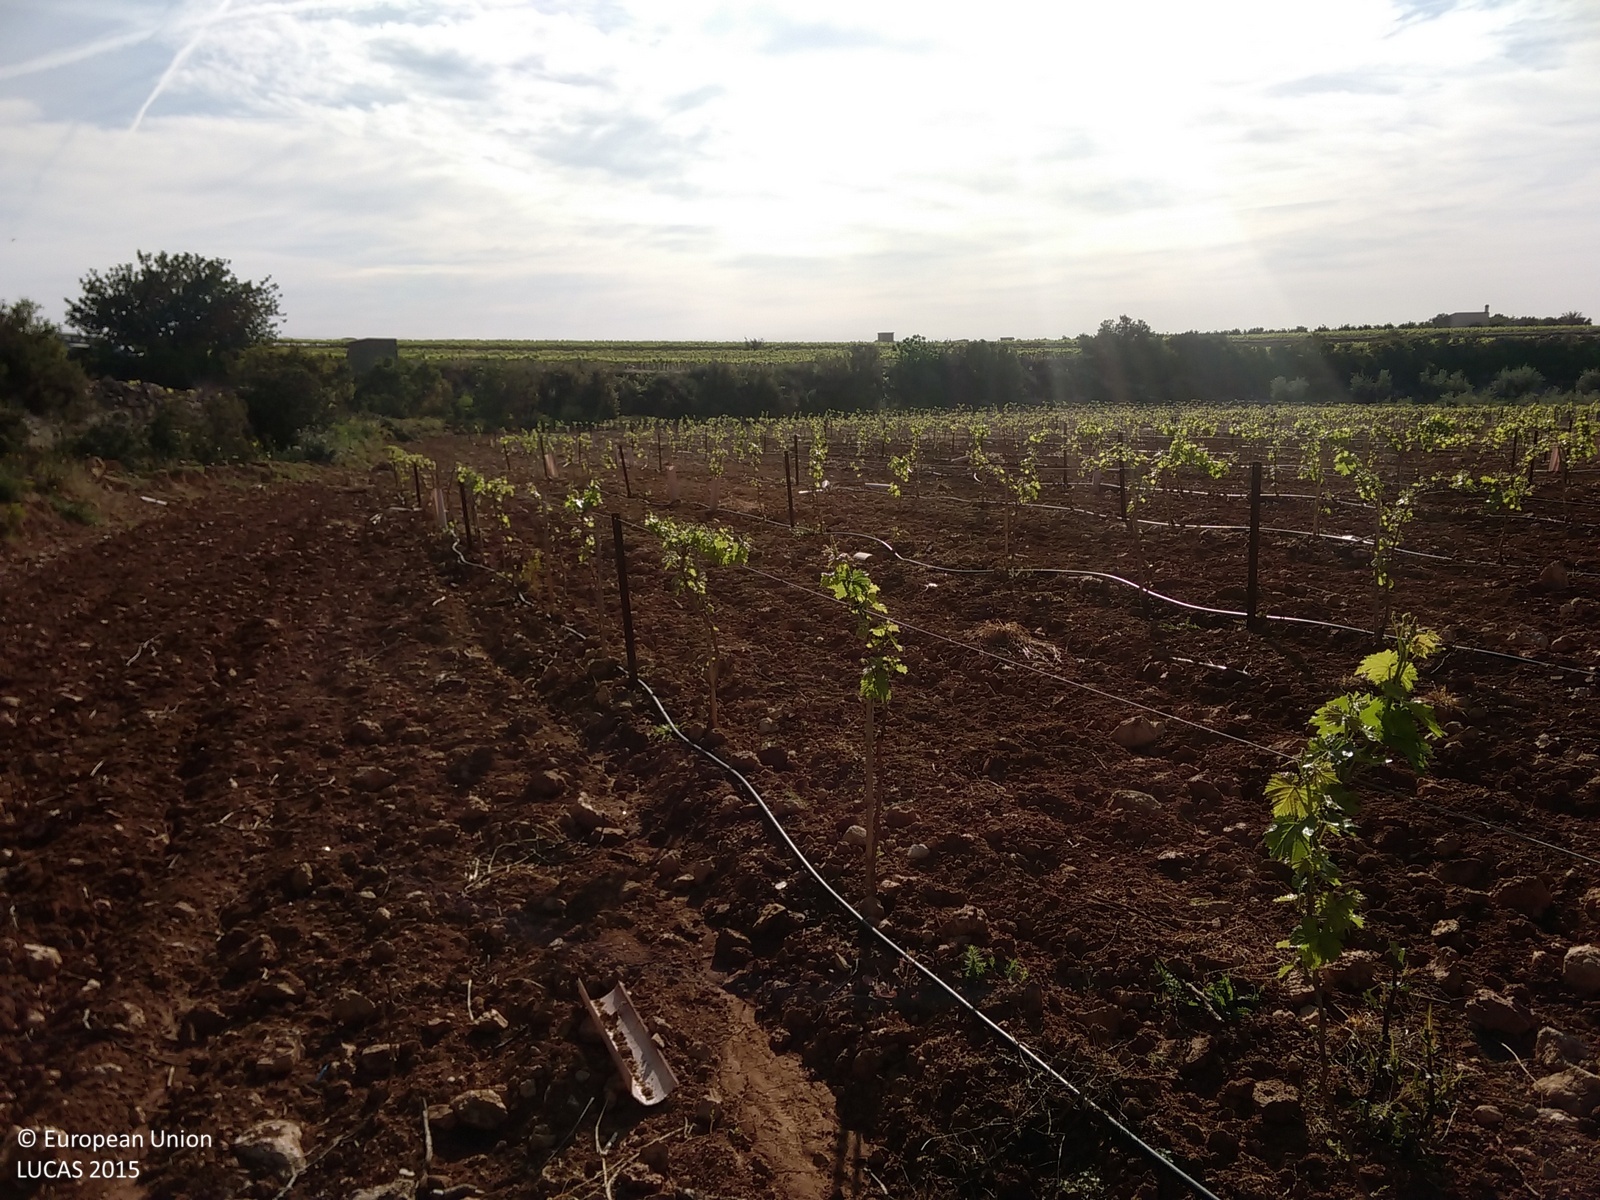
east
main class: Cropland
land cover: Vineyards
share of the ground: 10 - 25 %
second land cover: Other bare soil
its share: > 75 %
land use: Agriculture (excluding fallow land and kitchen gardens)
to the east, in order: Vineyards; Other bare soil; Rivers and streams; Shrubland without tree cover; Vineyards; Grass margins; Vineyards; Paved roads, cycling and walking lanes; Grass margins; Vineyards; Grass margins; Dry stone walls; Other citrus fruit
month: April
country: ES
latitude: 39.4279
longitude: -0.6742
